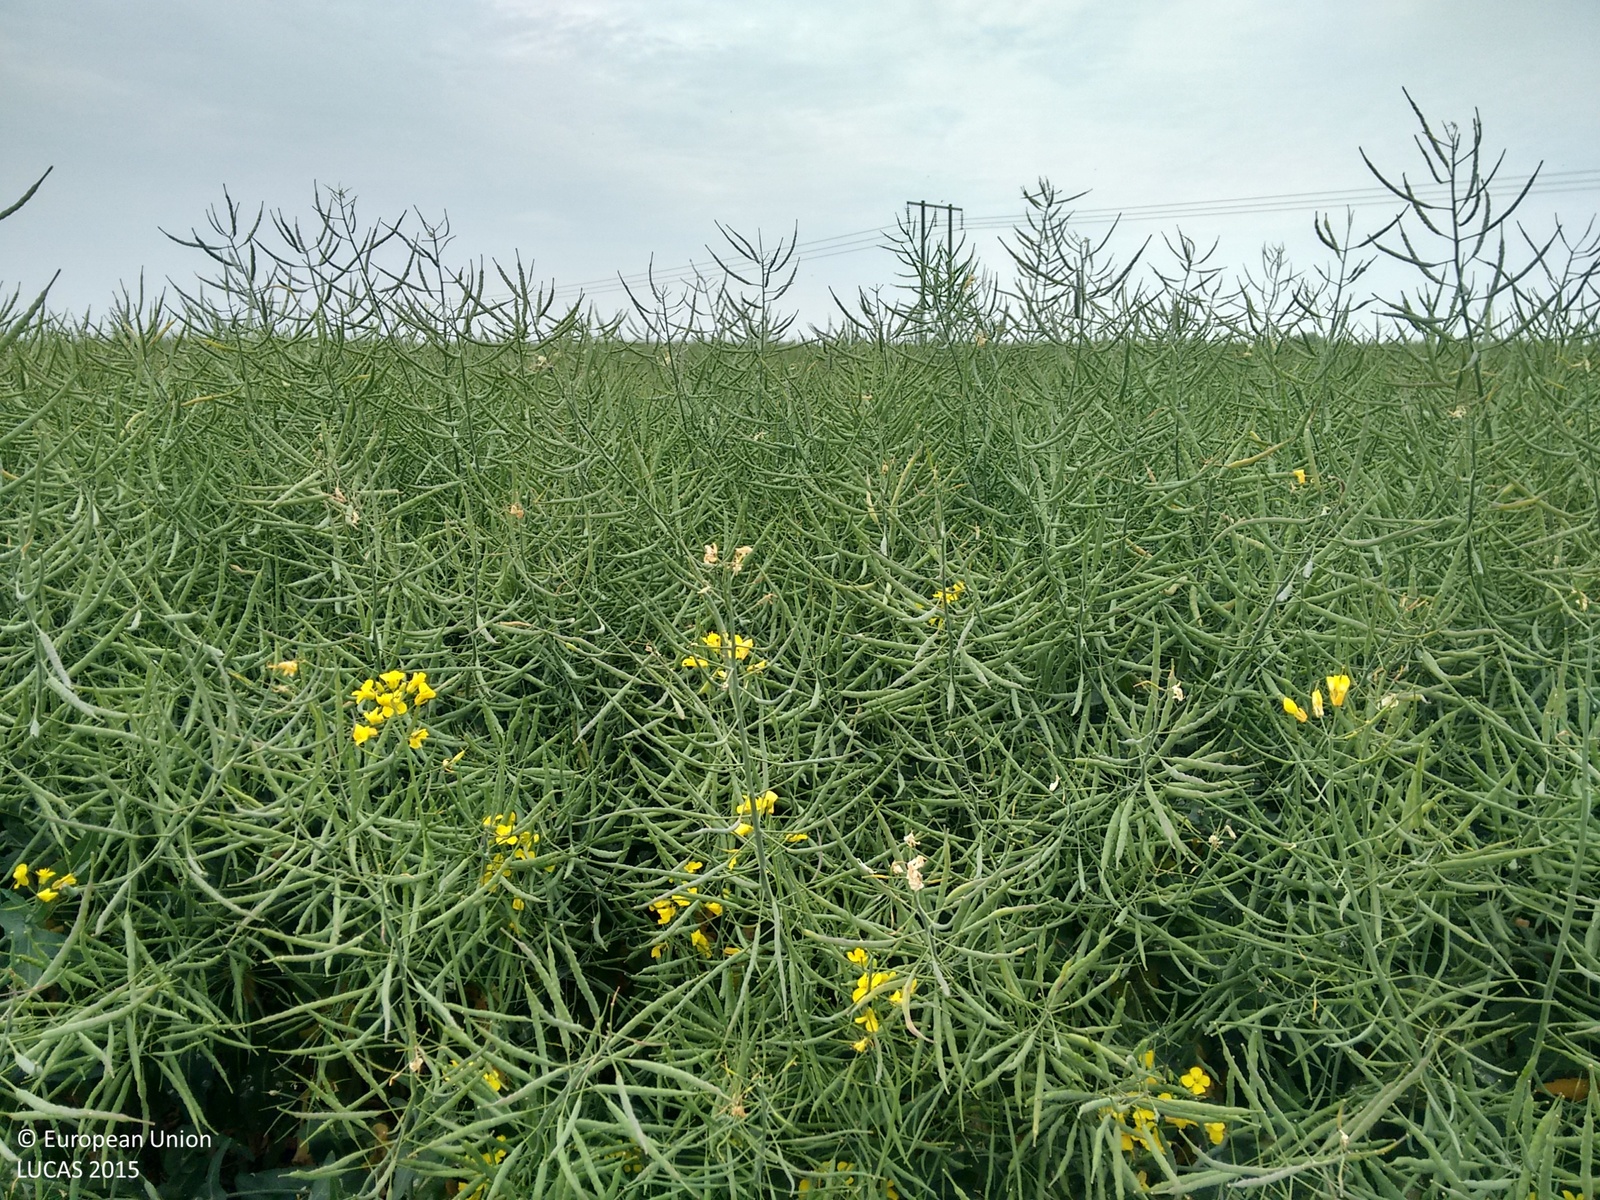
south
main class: Cropland
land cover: Rape and turnip rape
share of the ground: > 75 %
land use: Agriculture (excluding fallow land and kitchen gardens)
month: June
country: GB
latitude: 52.0916
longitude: -1.6569
